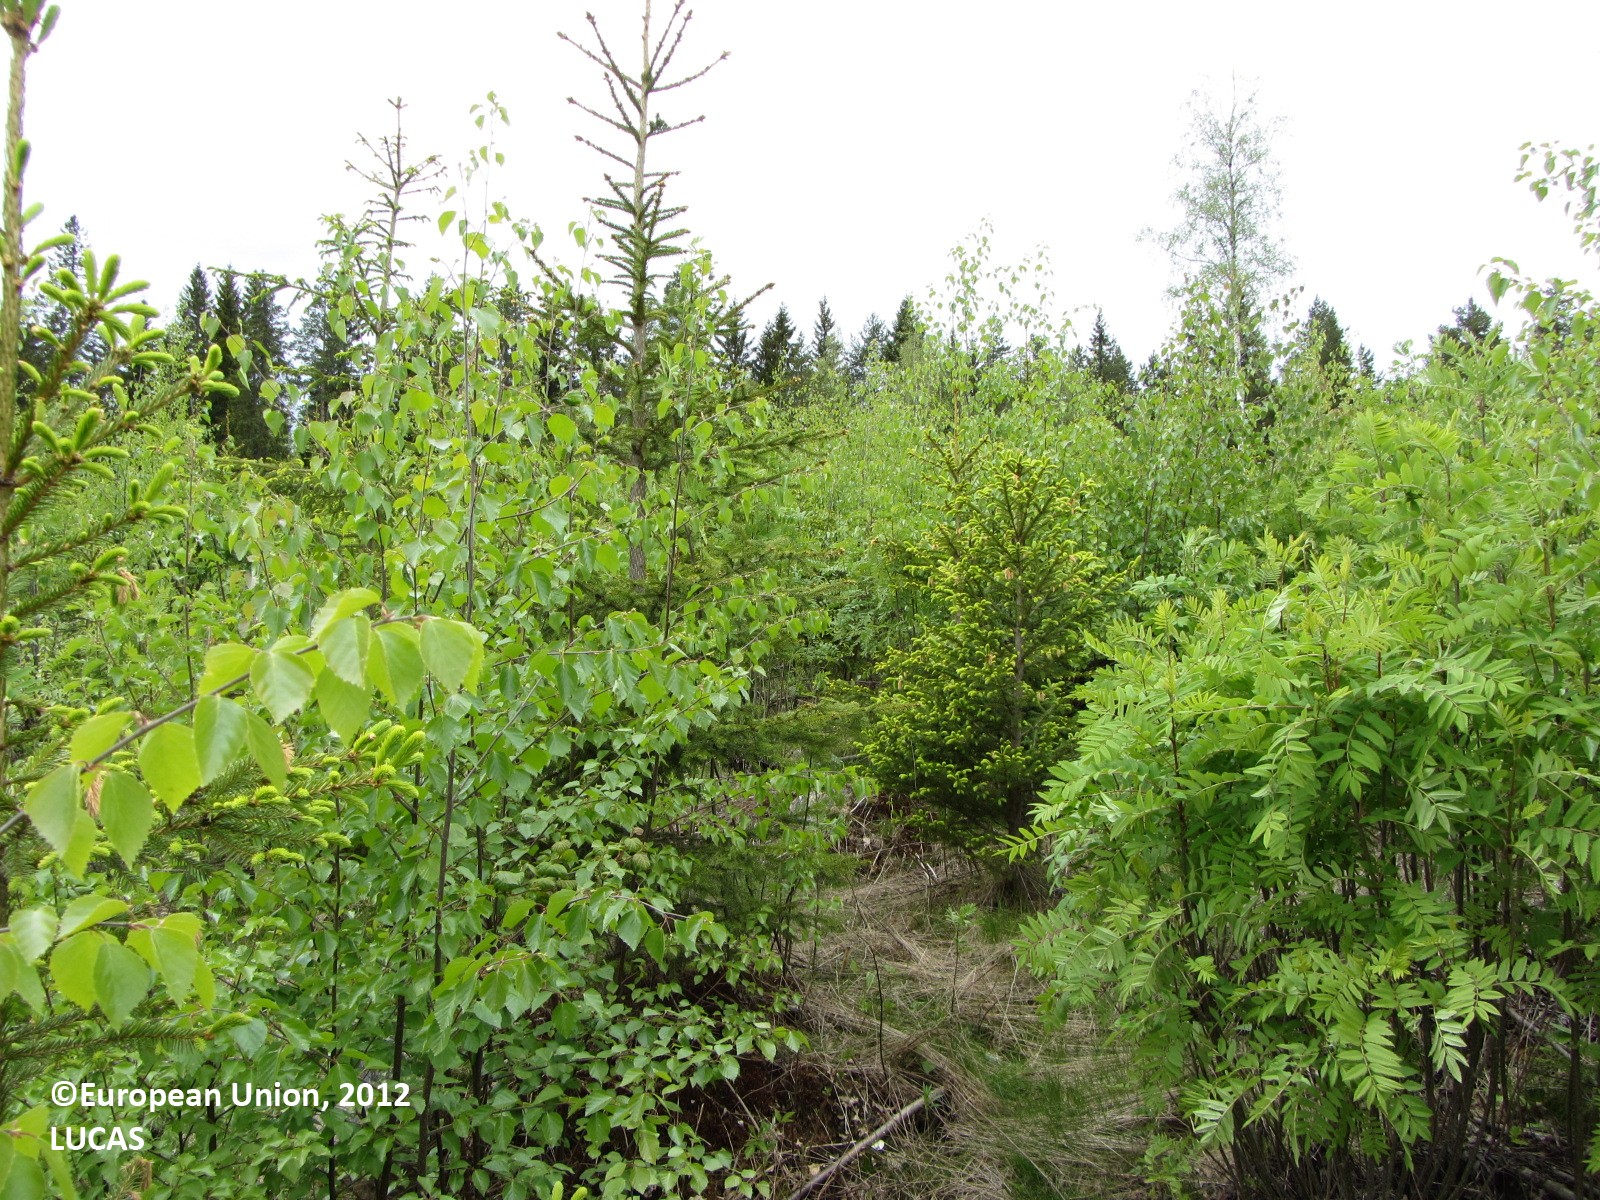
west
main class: Woodland
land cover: Spruce dominated mixed woodland
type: boreal forest
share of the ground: > 75 %
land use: Forestry
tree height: < 5 m
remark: Nursery
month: May
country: FI
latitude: 62.2360
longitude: 25.4102
